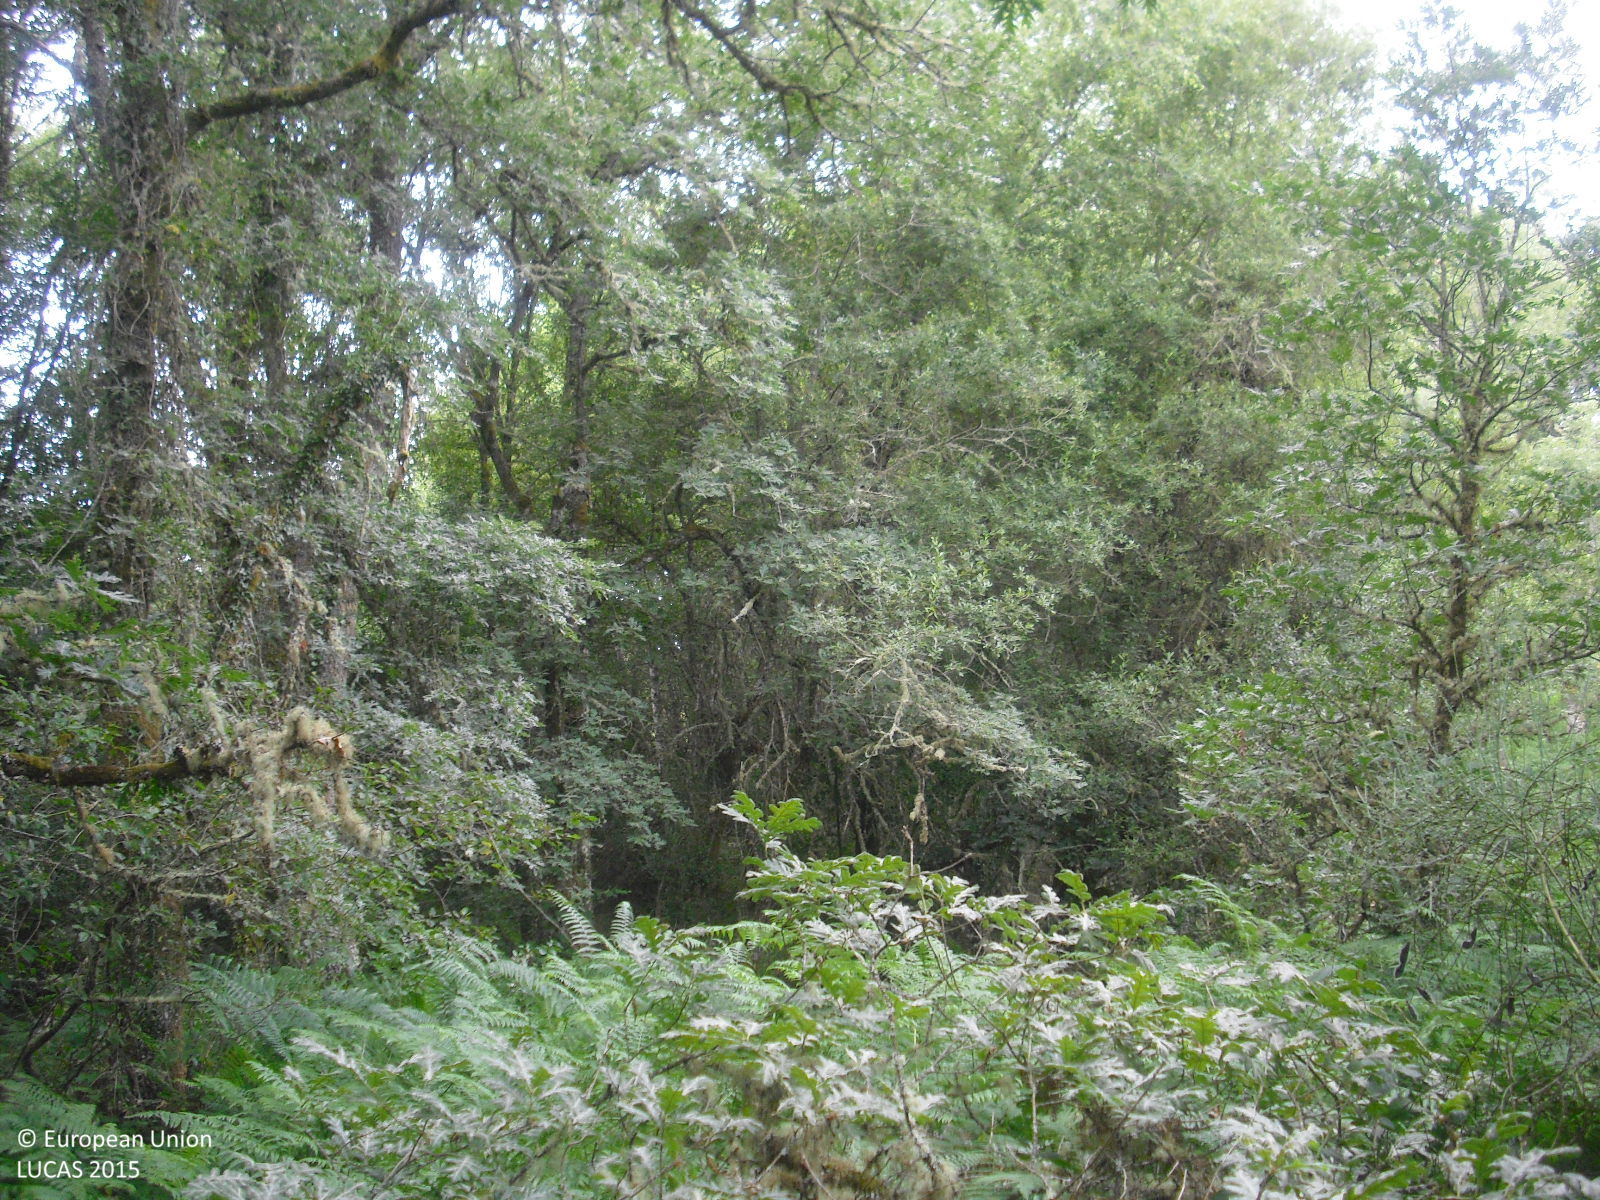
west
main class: Woodland
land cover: Broadleaved woodland
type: thermophilous deciduous forest
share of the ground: 50 - 75 %
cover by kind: broadleaved forest trees 60 %, shrubs 40 %
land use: Forestry
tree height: < 5 m
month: July
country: ES
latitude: 42.3403
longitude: -7.4592
